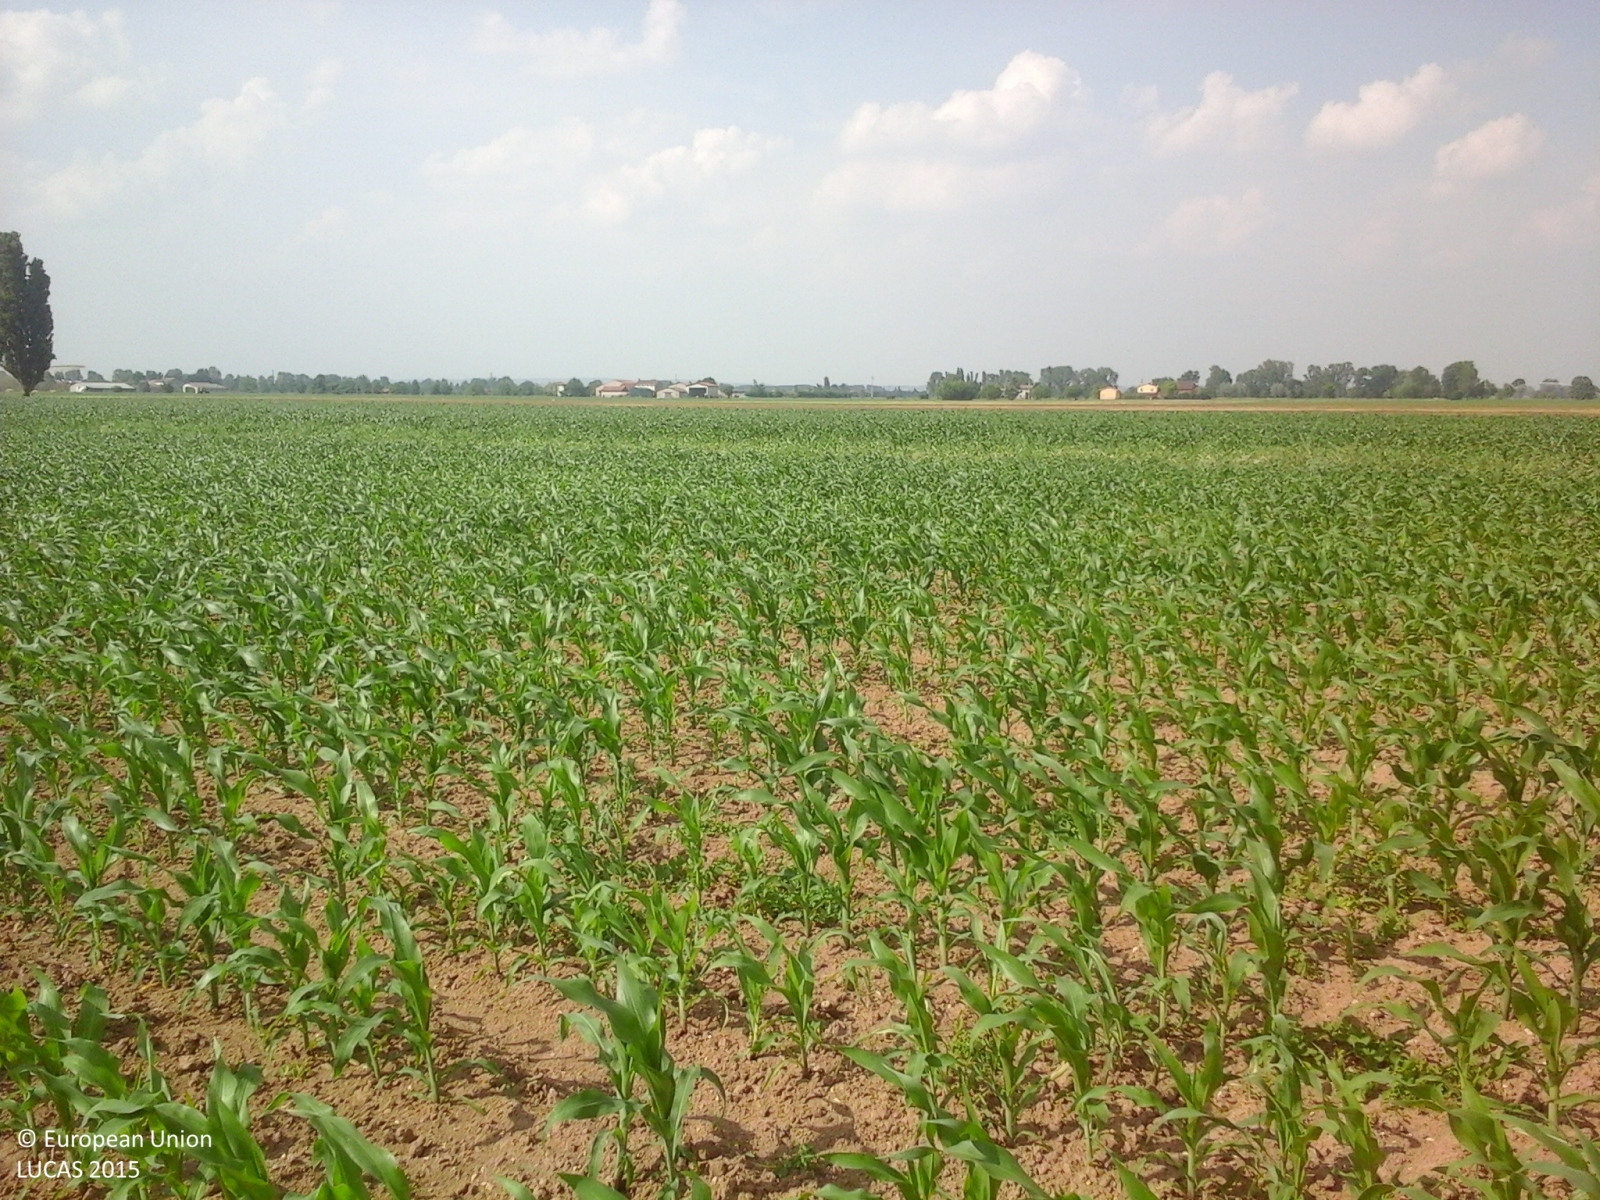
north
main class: Cropland
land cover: Maize
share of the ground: 25 - 50 %
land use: Agriculture (excluding fallow land and kitchen gardens)
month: May
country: IT
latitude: 45.2322
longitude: 10.6230
